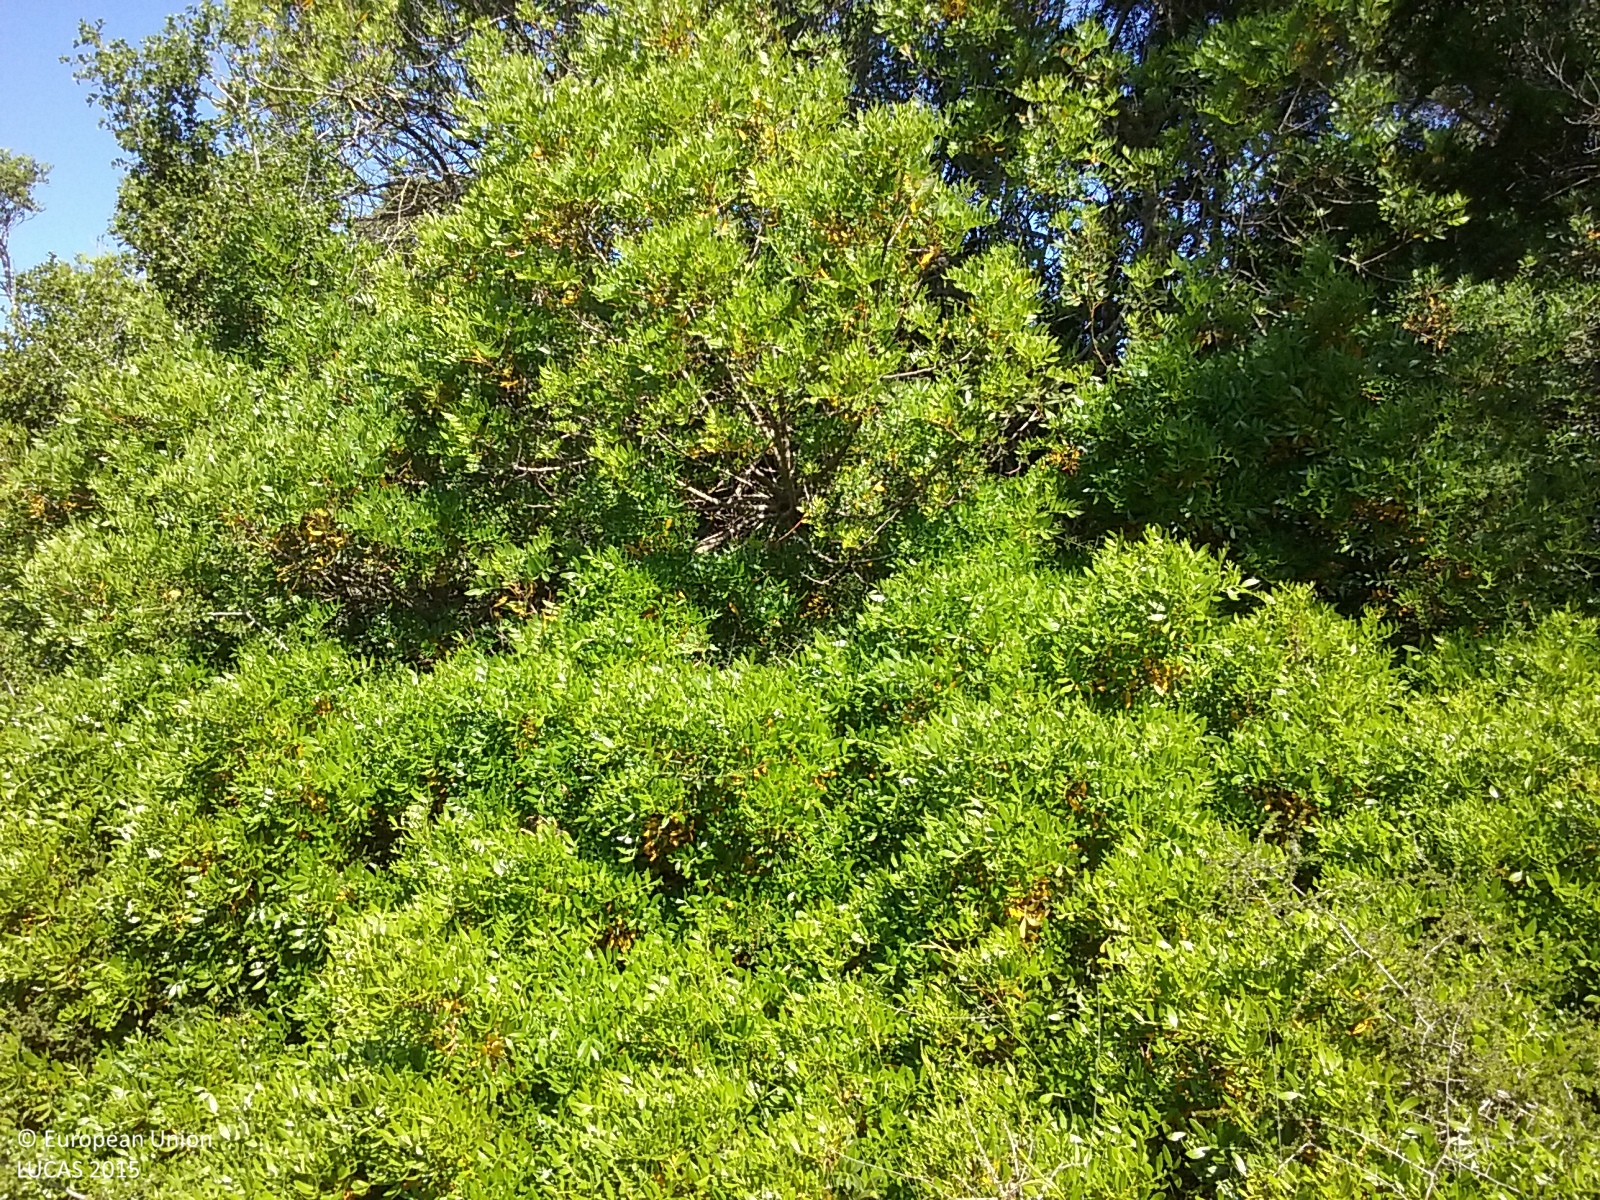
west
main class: Shrubland
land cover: Shrubland with sparse tree cover
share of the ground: > 75 %
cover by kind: shrubs 75 %, herbaceous plants 10 %, broadleaved forest trees 5 %
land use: Semi-natural and natural areas not in use
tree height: < 5 m
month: May
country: ES
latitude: 40.3687
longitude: 0.3045
